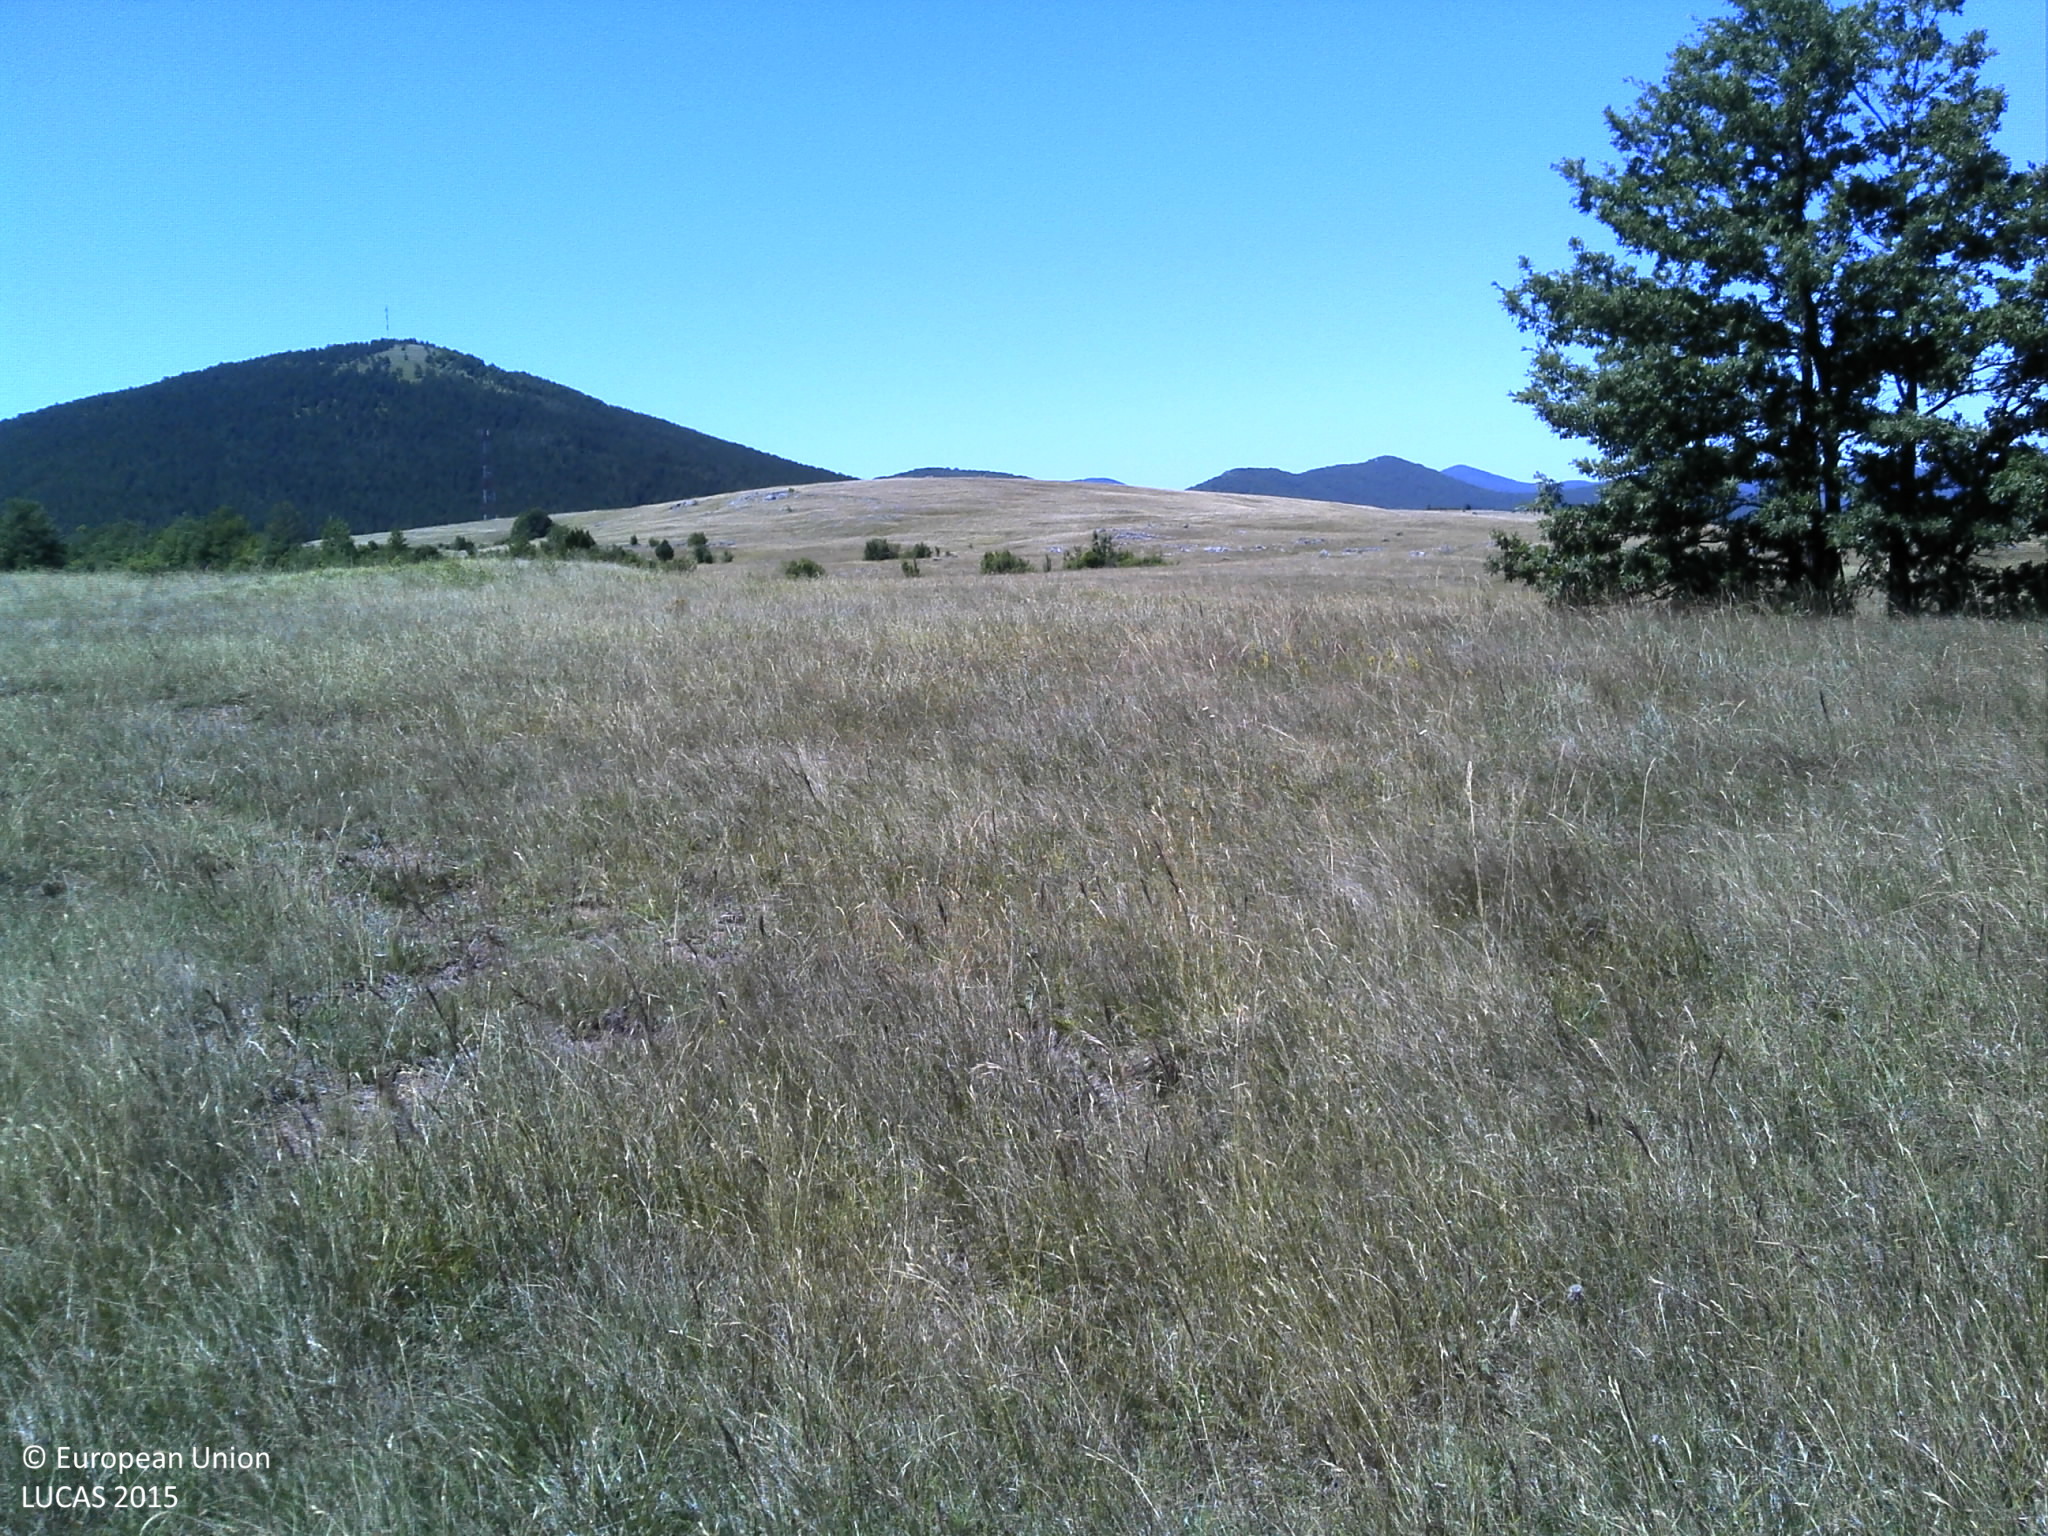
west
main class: Grassland
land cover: Grassland without tree/shrub cover
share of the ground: > 75 %
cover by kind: herbaceous plants 95 %, shrubs 5 %
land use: Agriculture (excluding fallow land and kitchen gardens)
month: July
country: HR
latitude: 44.4172
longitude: 15.9089
